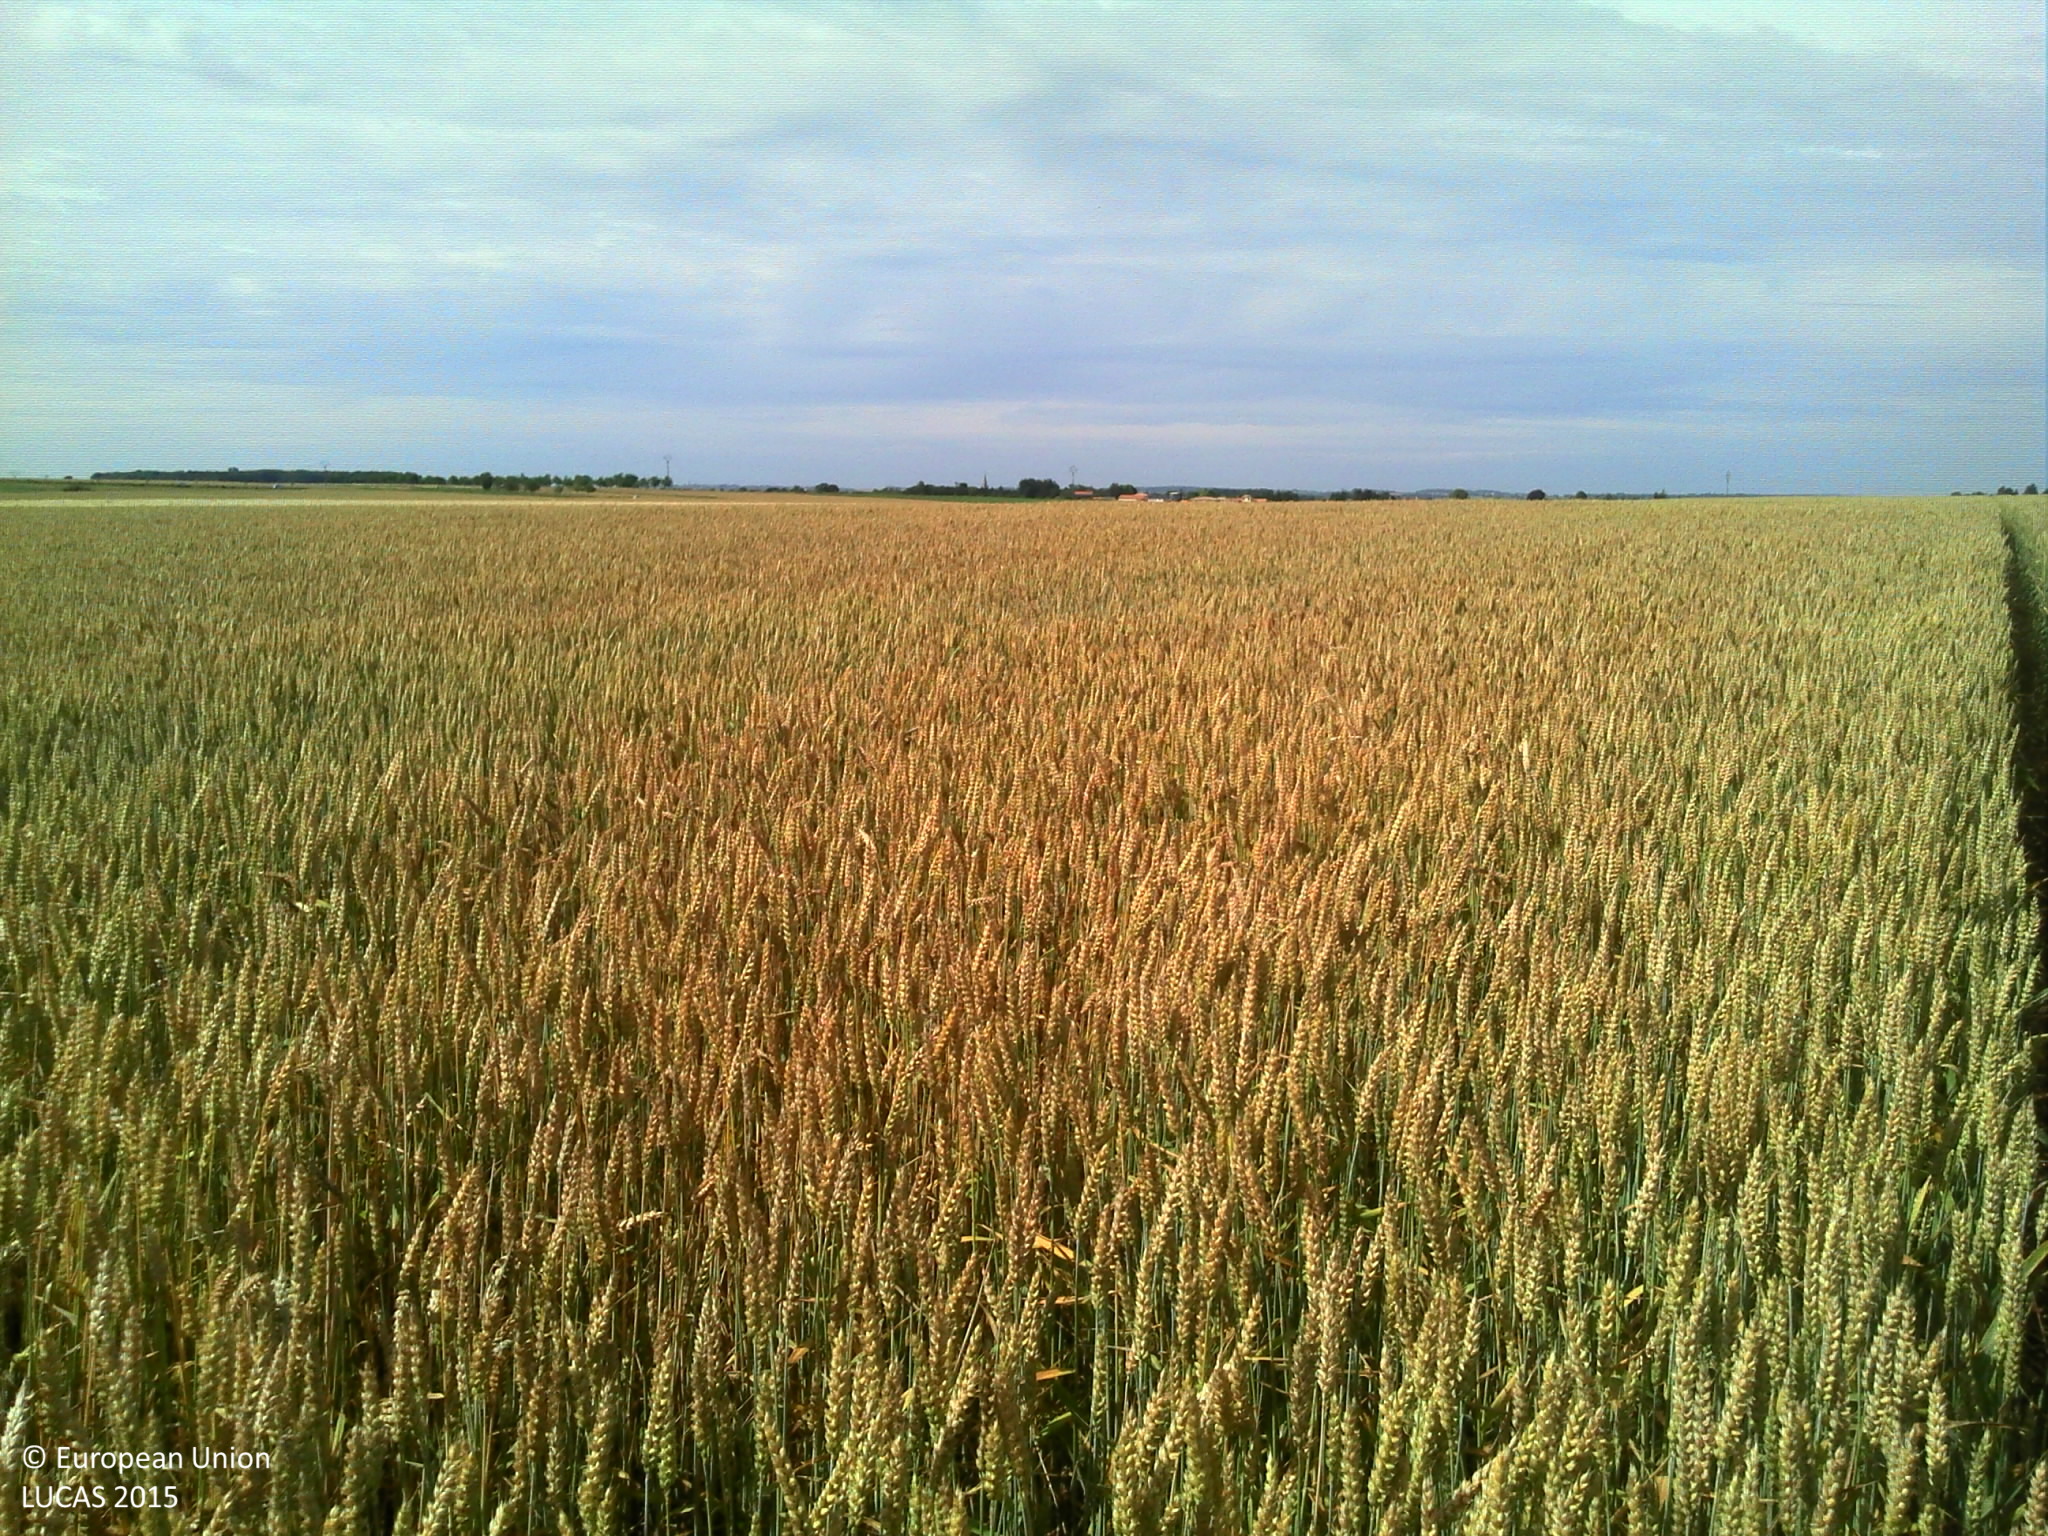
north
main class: Cropland
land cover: Common wheat
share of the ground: > 75 %
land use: Agriculture (excluding fallow land and kitchen gardens)
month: June
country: FR
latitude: 46.6634
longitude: 0.2166
